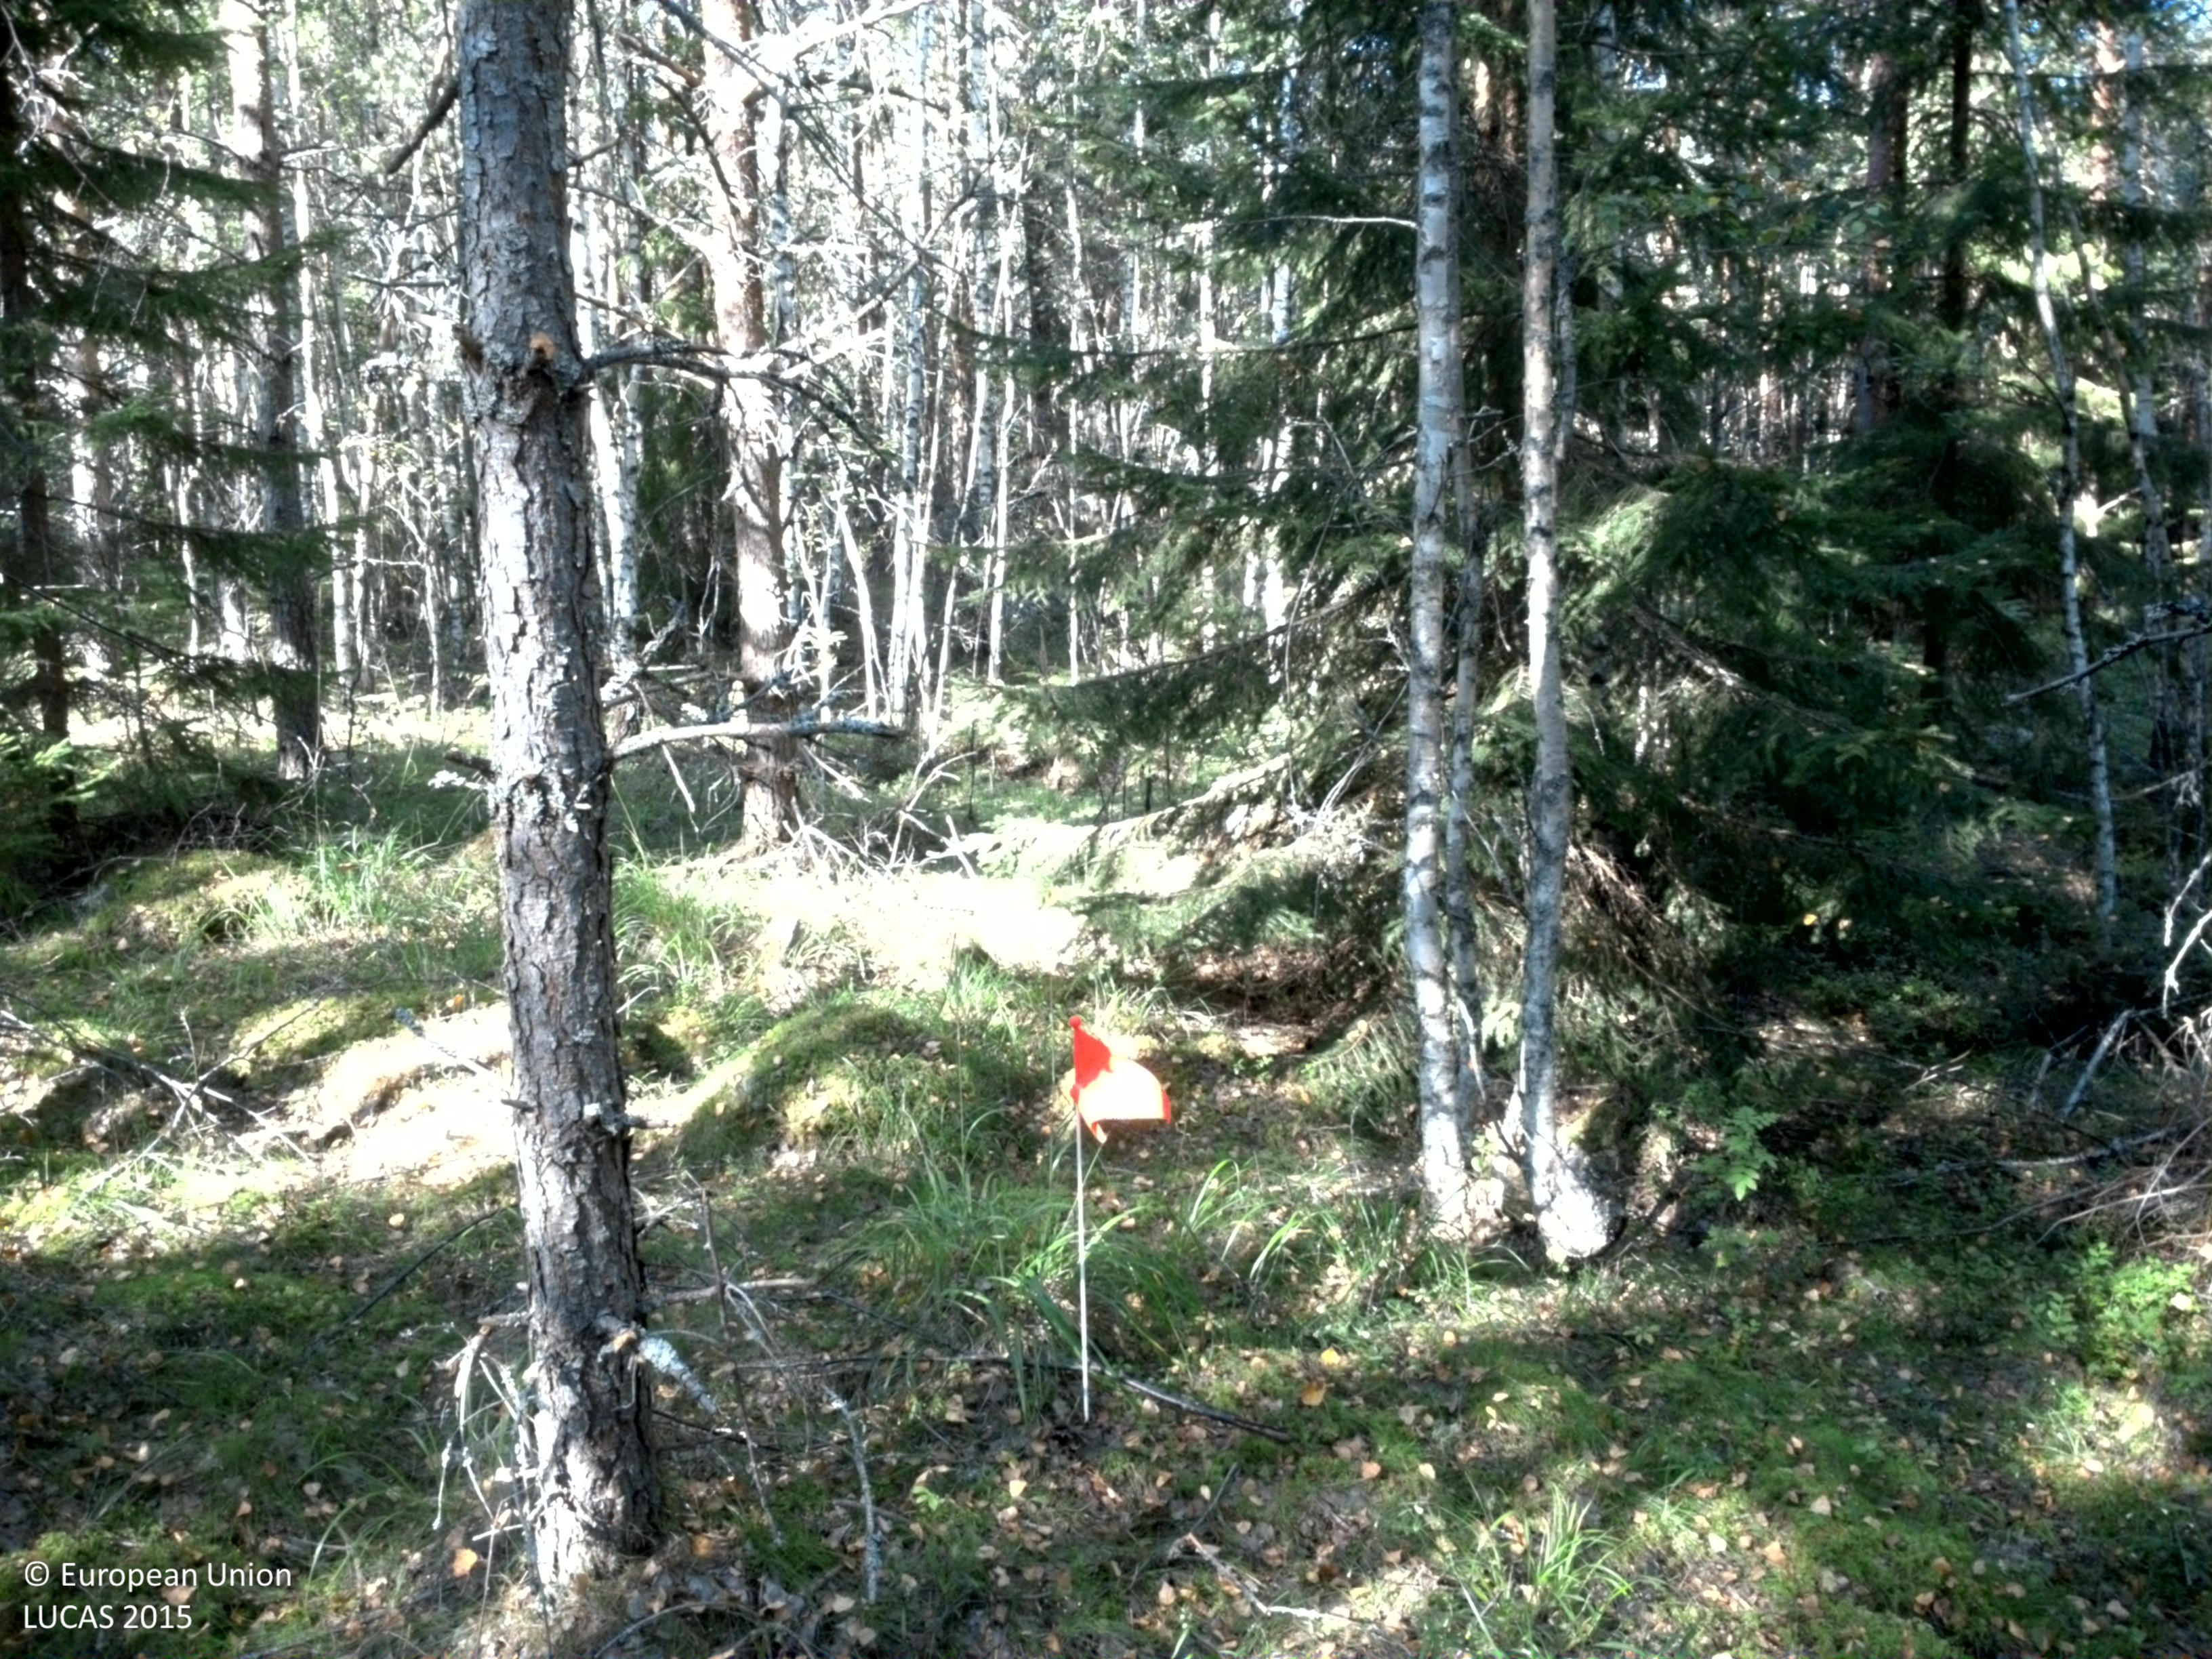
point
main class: Woodland
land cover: Pine dominated mixed woodland
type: boreal forest
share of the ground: > 75 %
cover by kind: broadleaved forest trees 45 %, coniferous forest trees 35 %, lichens and mosses 10 %, shrubs 5 %, herbaceous plants 5 %
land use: Forestry
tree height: > 5 m
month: August
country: SE
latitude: 59.6033
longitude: 15.9623
